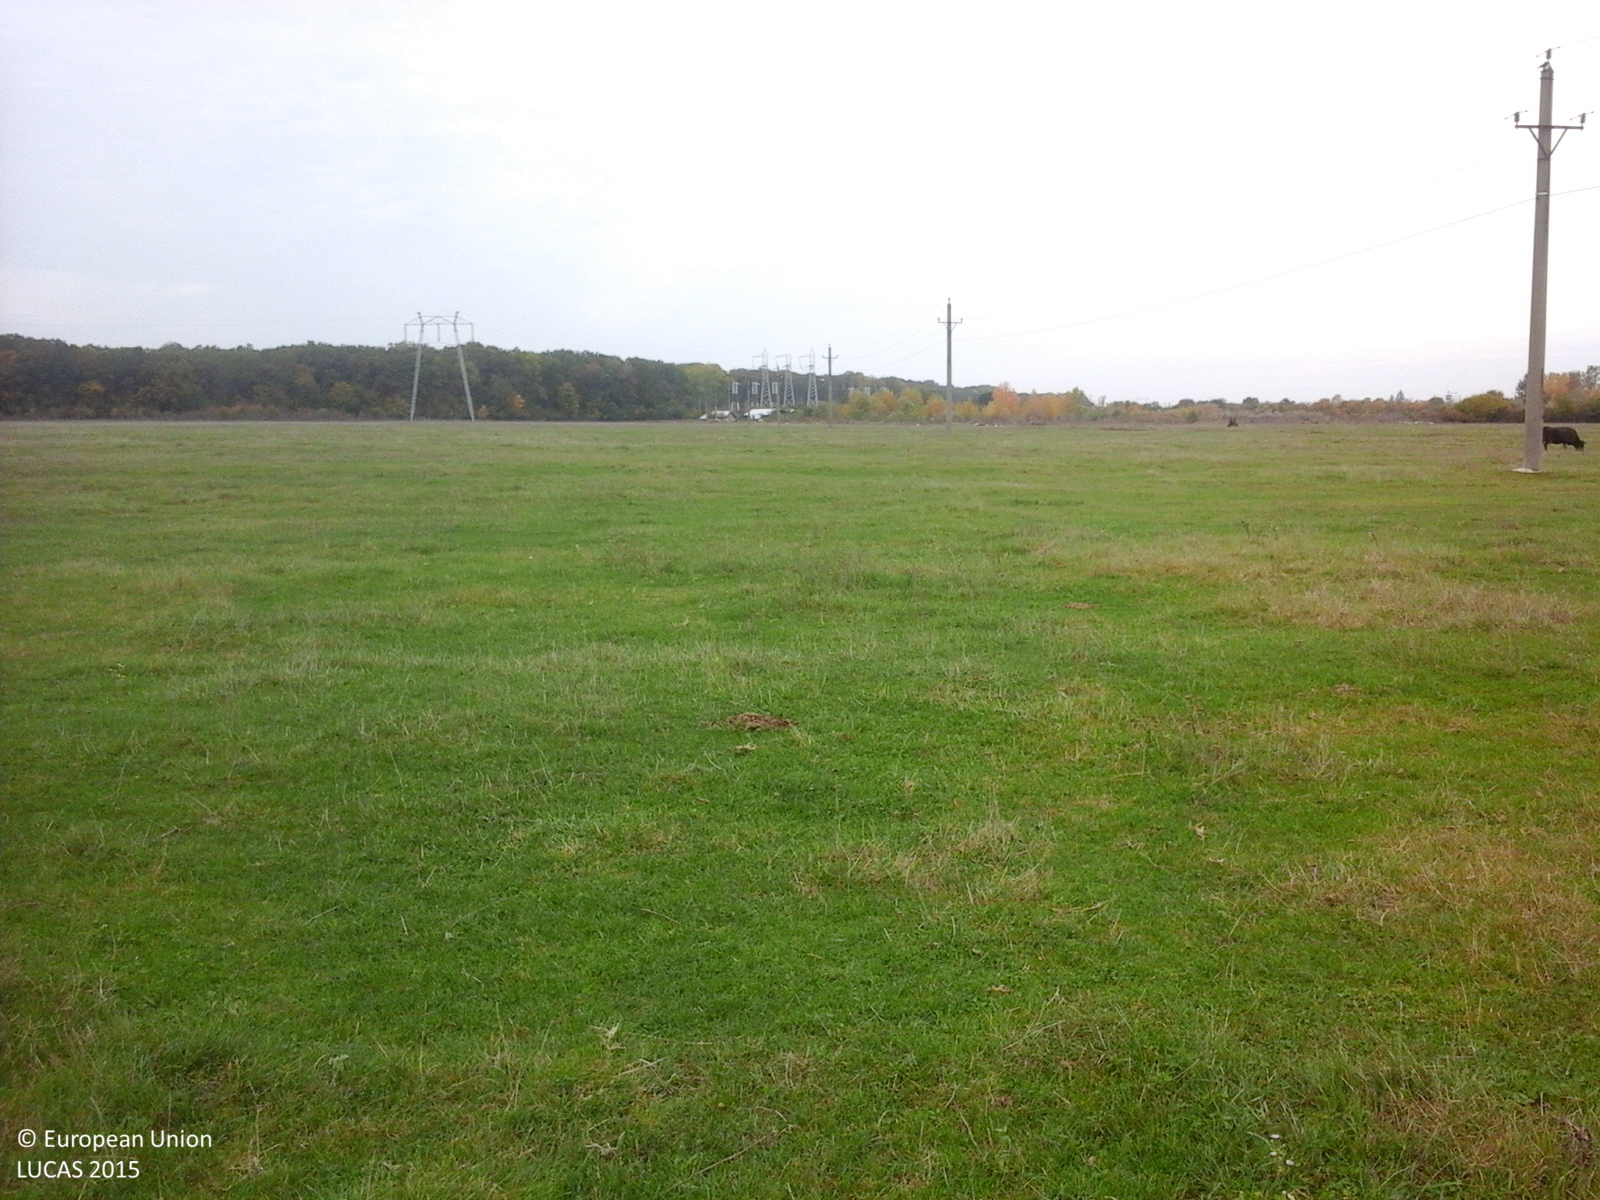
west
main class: Grassland
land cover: Grassland without tree/shrub cover
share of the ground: > 75 %
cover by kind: herbaceous plants 100 %
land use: Agriculture (excluding fallow land and kitchen gardens)
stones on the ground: < 10 %
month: October
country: RO
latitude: 44.8478
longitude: 26.0889
